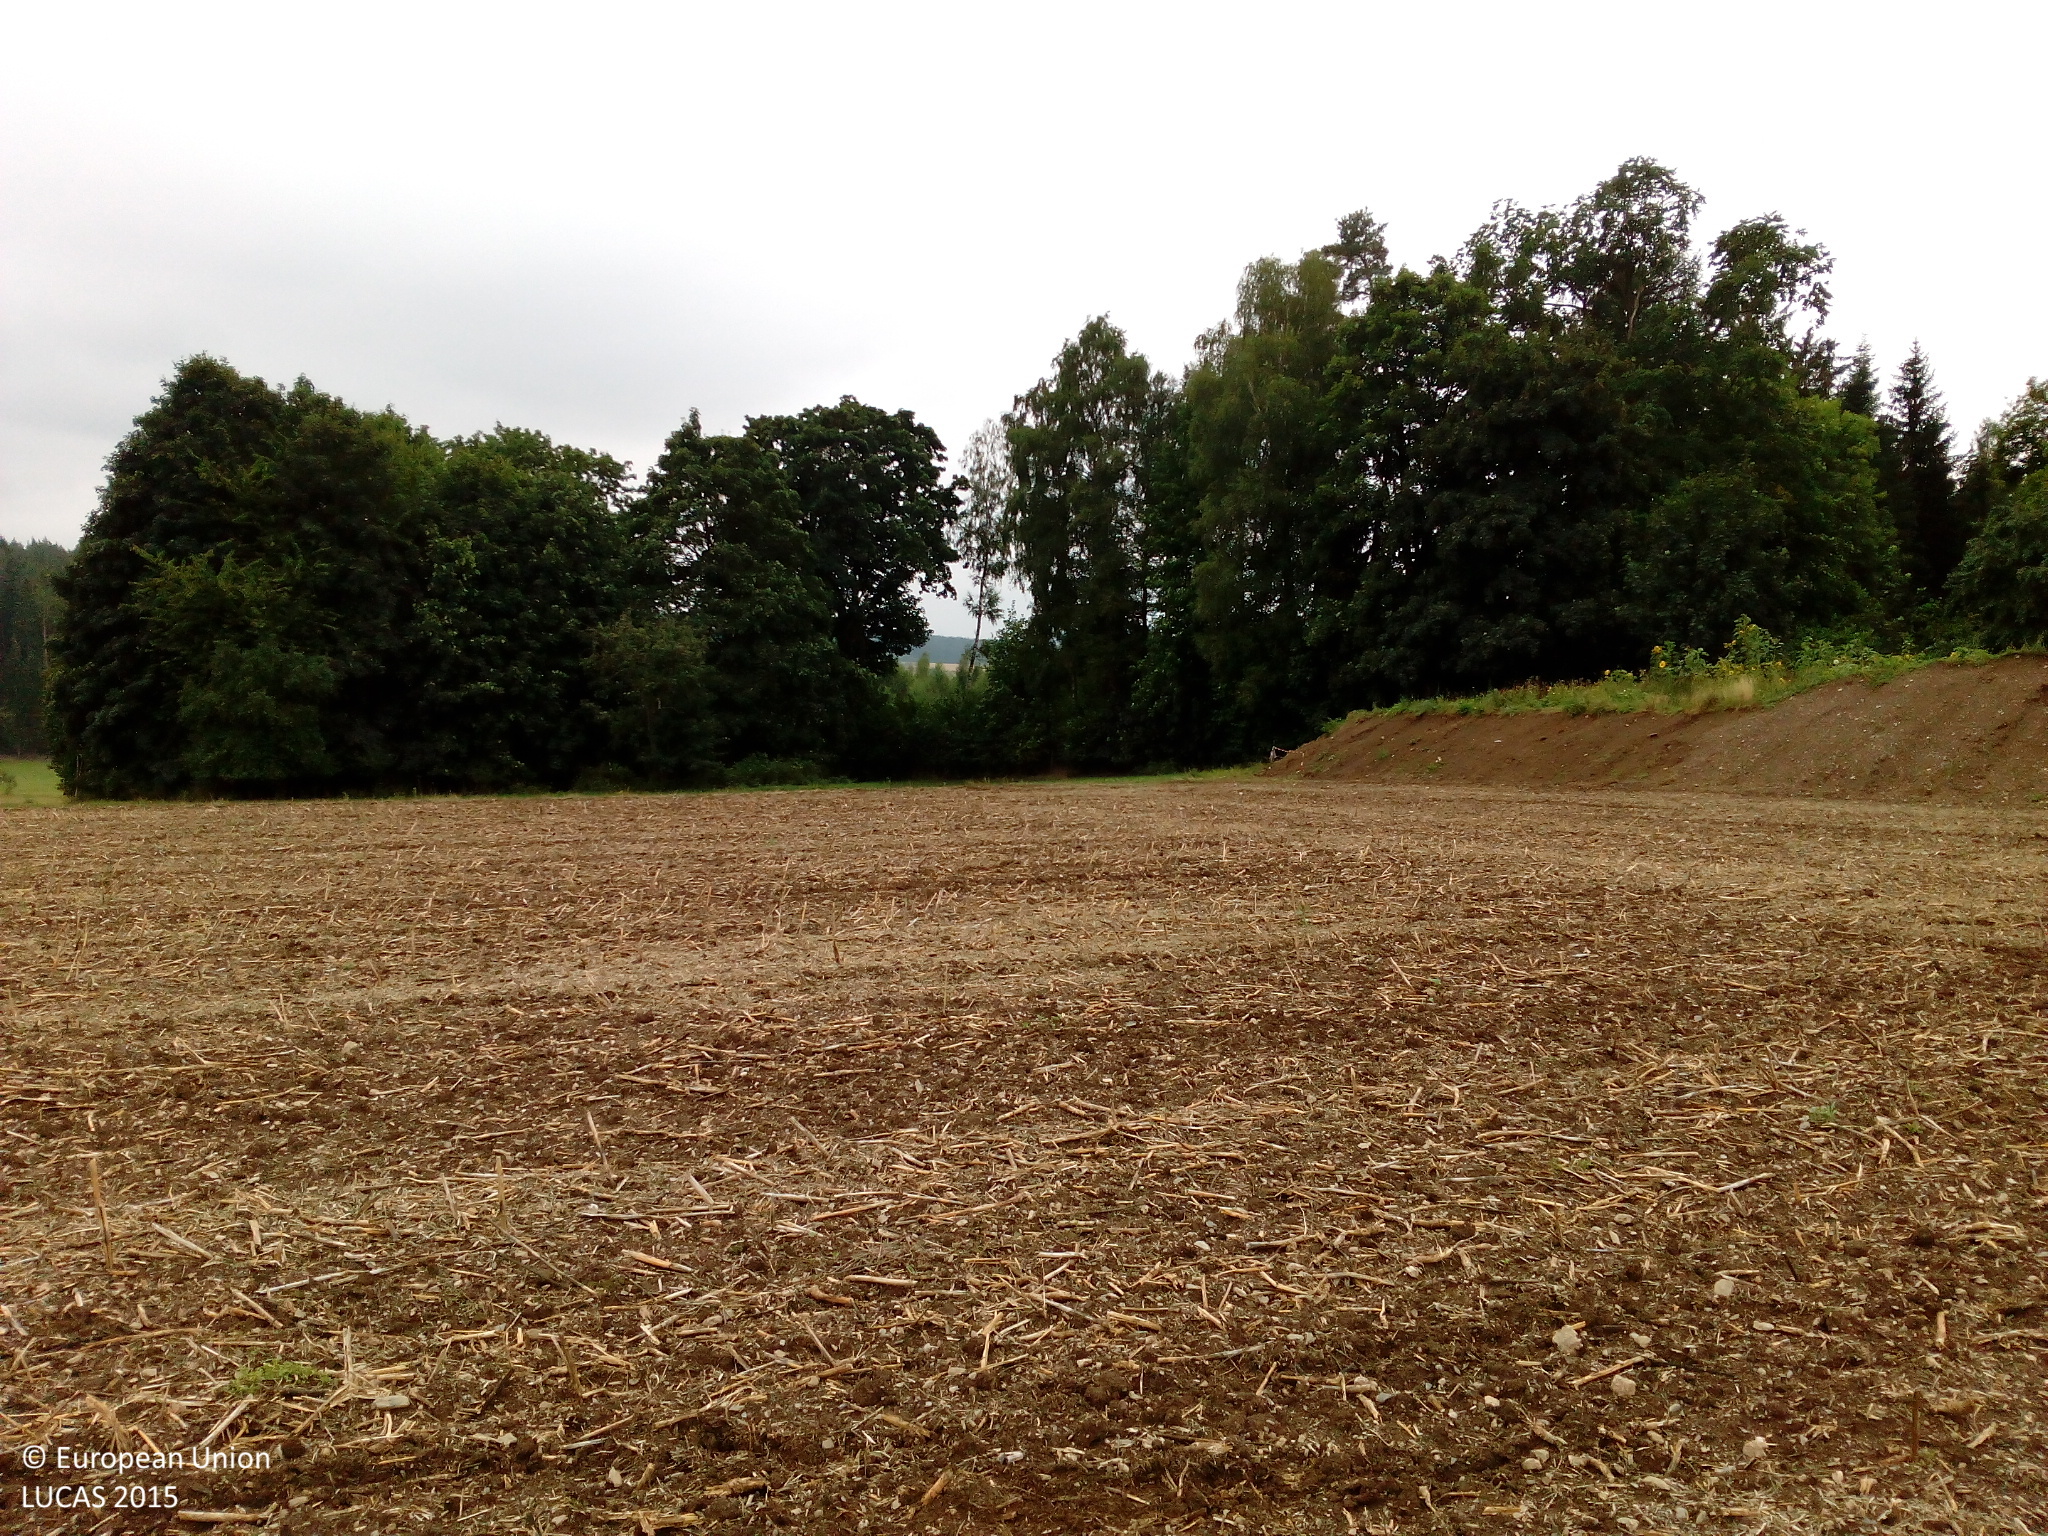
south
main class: Cropland
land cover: Rape and turnip rape
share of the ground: < 10 %
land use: Agriculture (excluding fallow land and kitchen gardens)
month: August
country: DE
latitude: 50.2211
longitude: 11.9758
